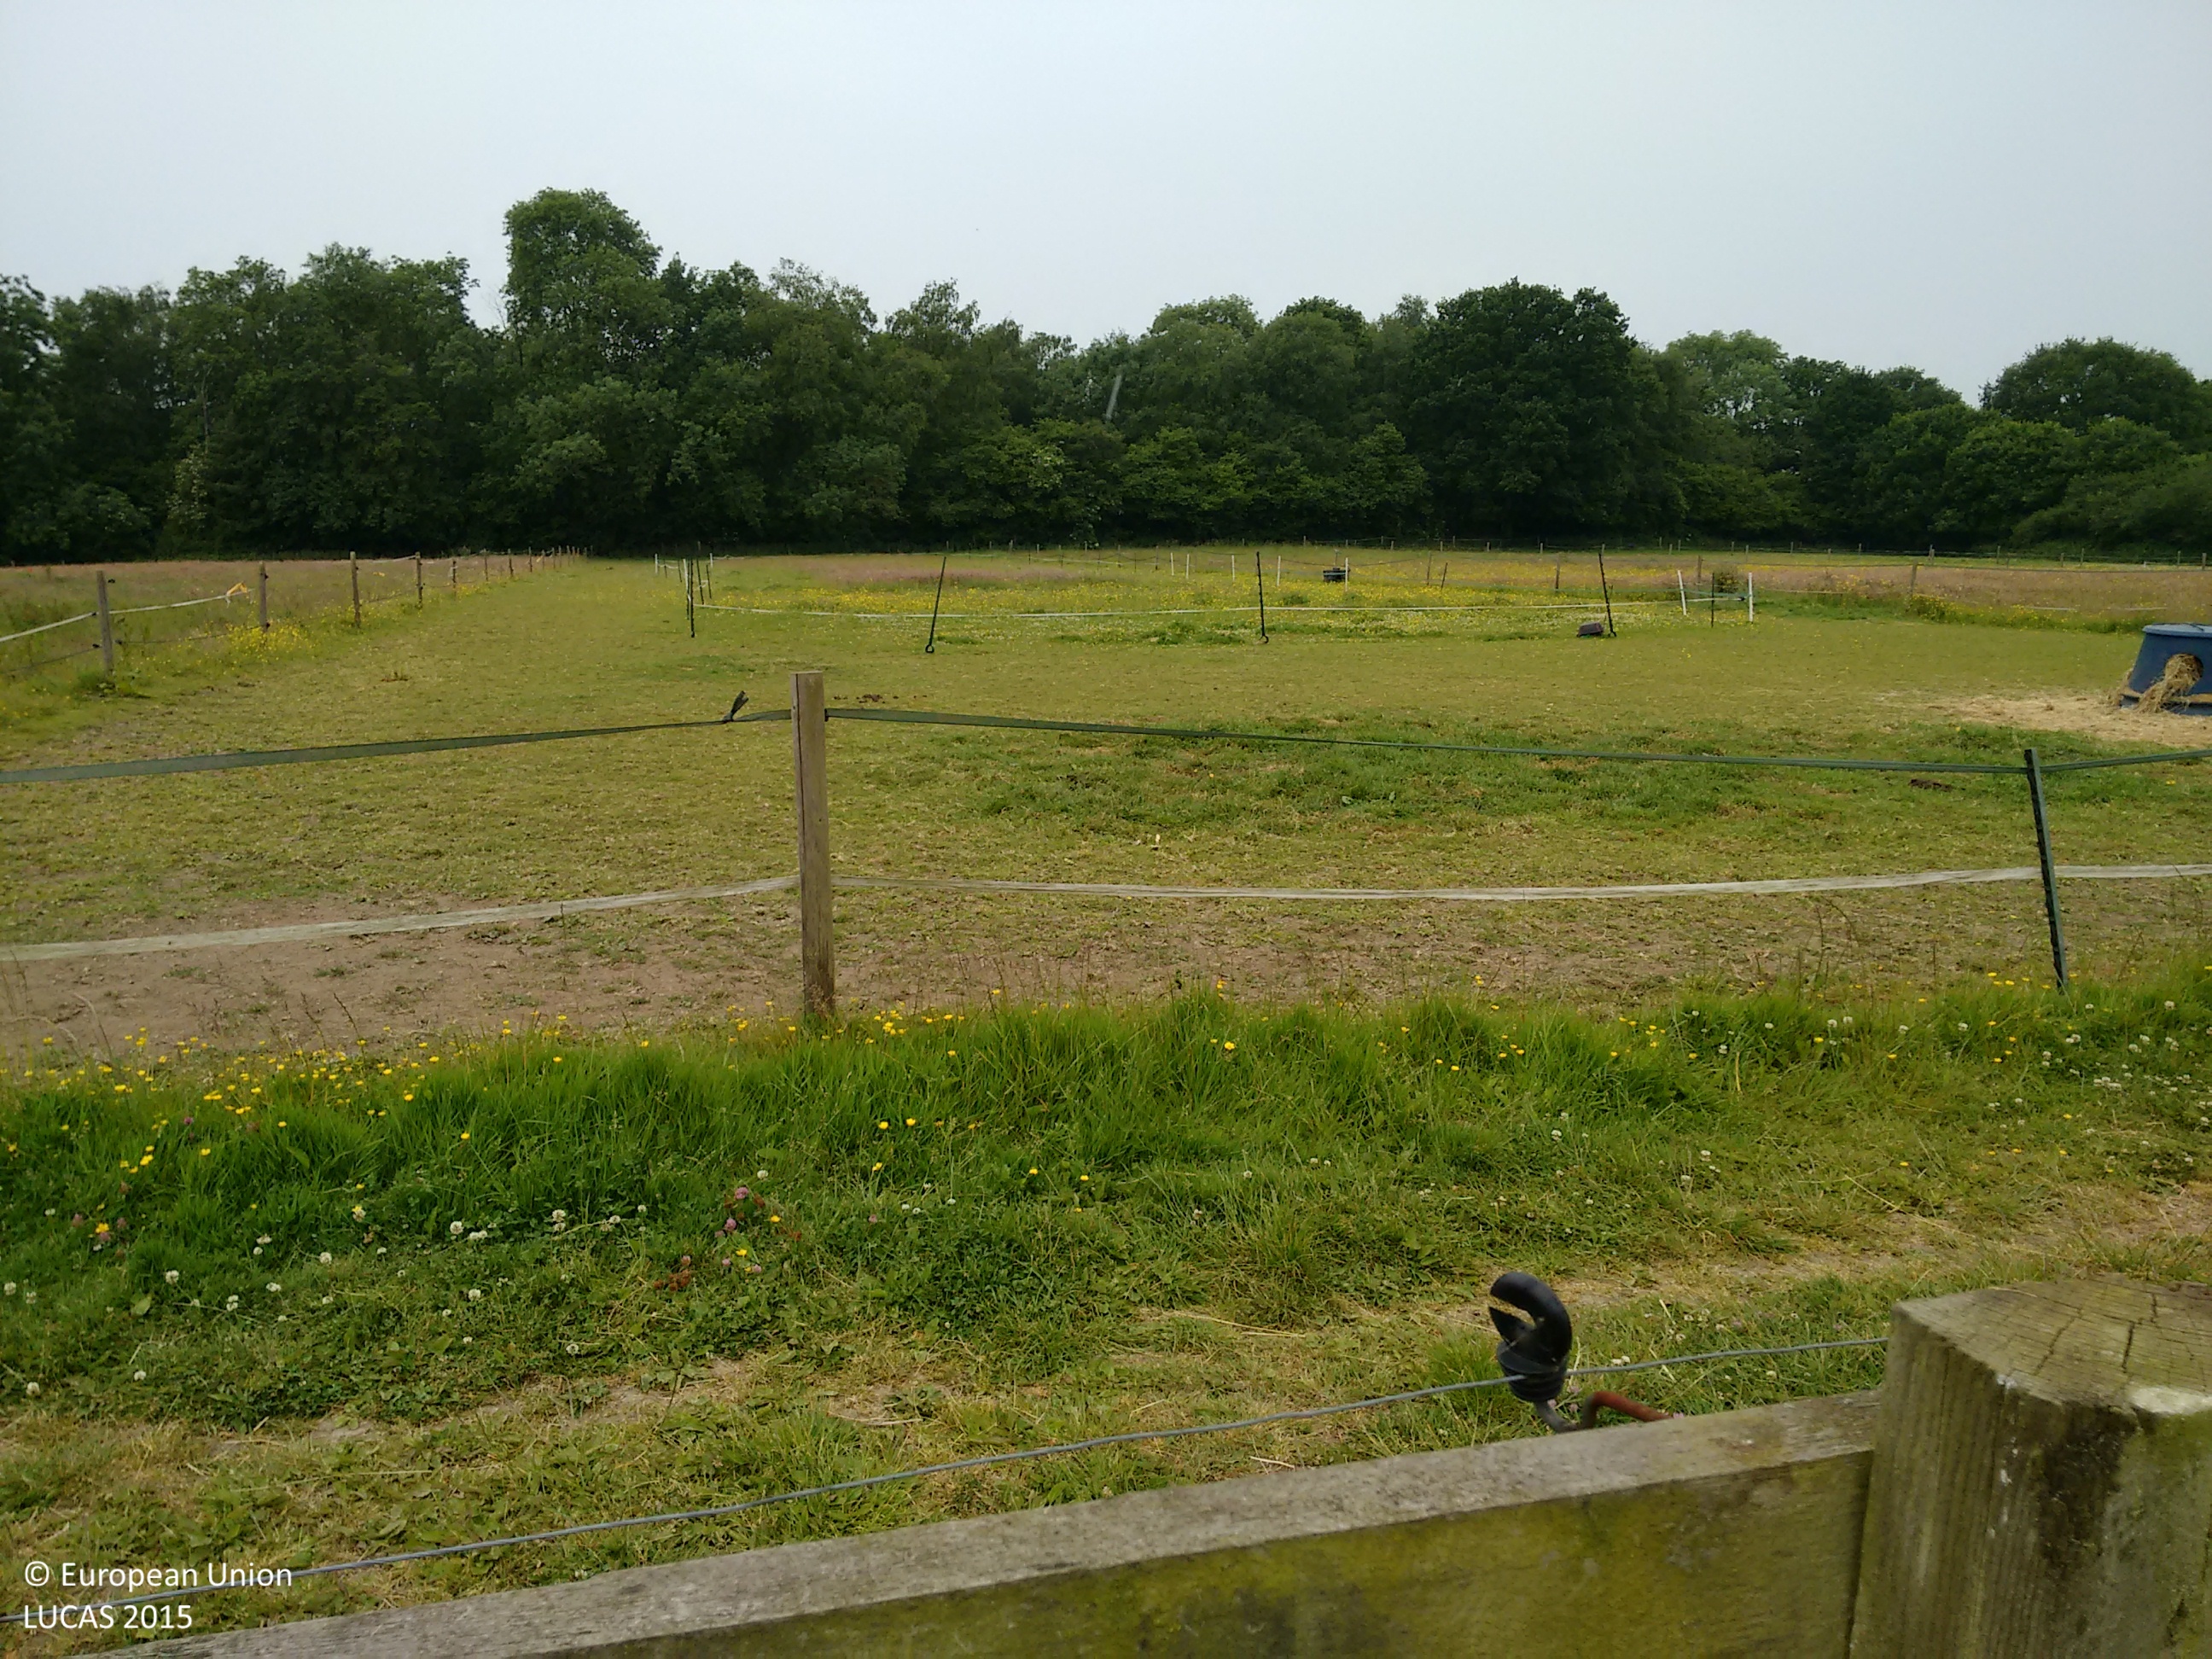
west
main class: Grassland
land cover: Grassland without tree/shrub cover
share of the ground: > 75 %
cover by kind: herbaceous plants 100 %
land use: Agriculture (excluding fallow land and kitchen gardens)
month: June
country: GB
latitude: 51.4136
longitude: -1.1610
